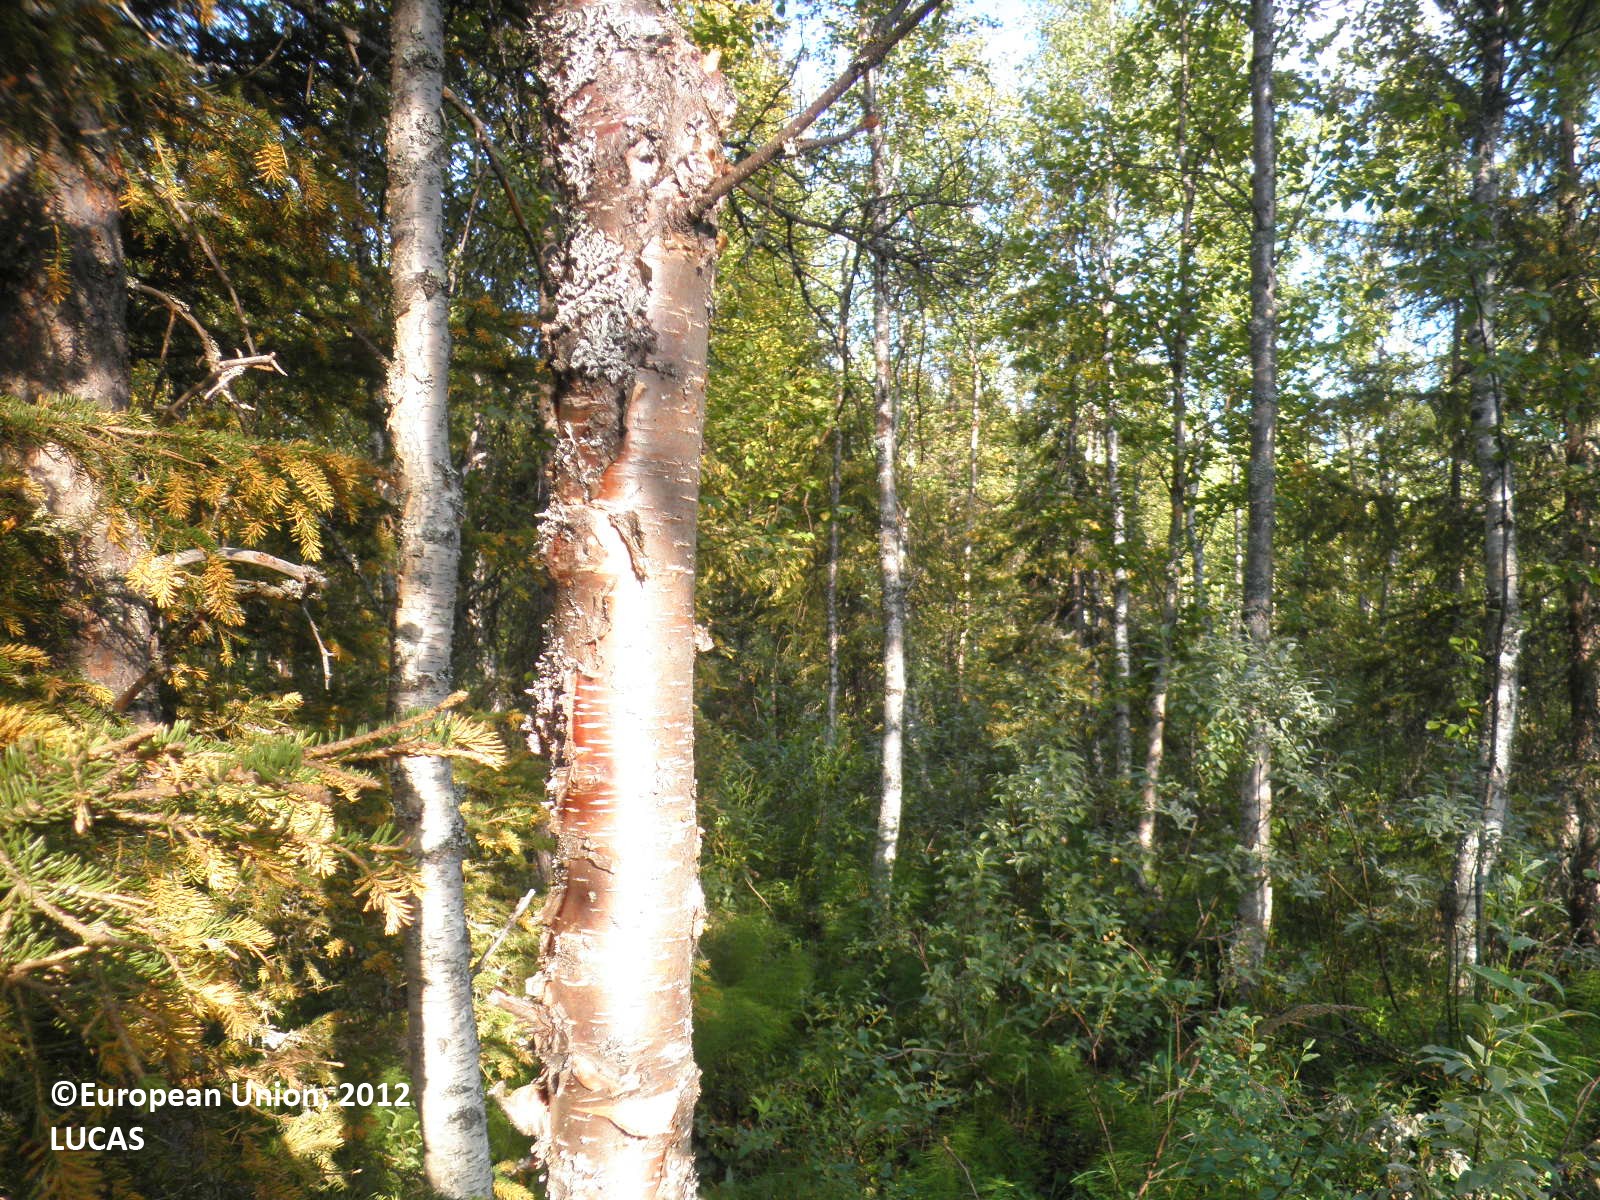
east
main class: Woodland
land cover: Spruce dominated mixed woodland
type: boreal forest
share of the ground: > 75 %
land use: Forestry
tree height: > 5 m
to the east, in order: Spruce dominated mixed woodland; Broadleaved woodland; Inland water bodies
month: August
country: FI
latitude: 67.5382
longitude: 25.5049
